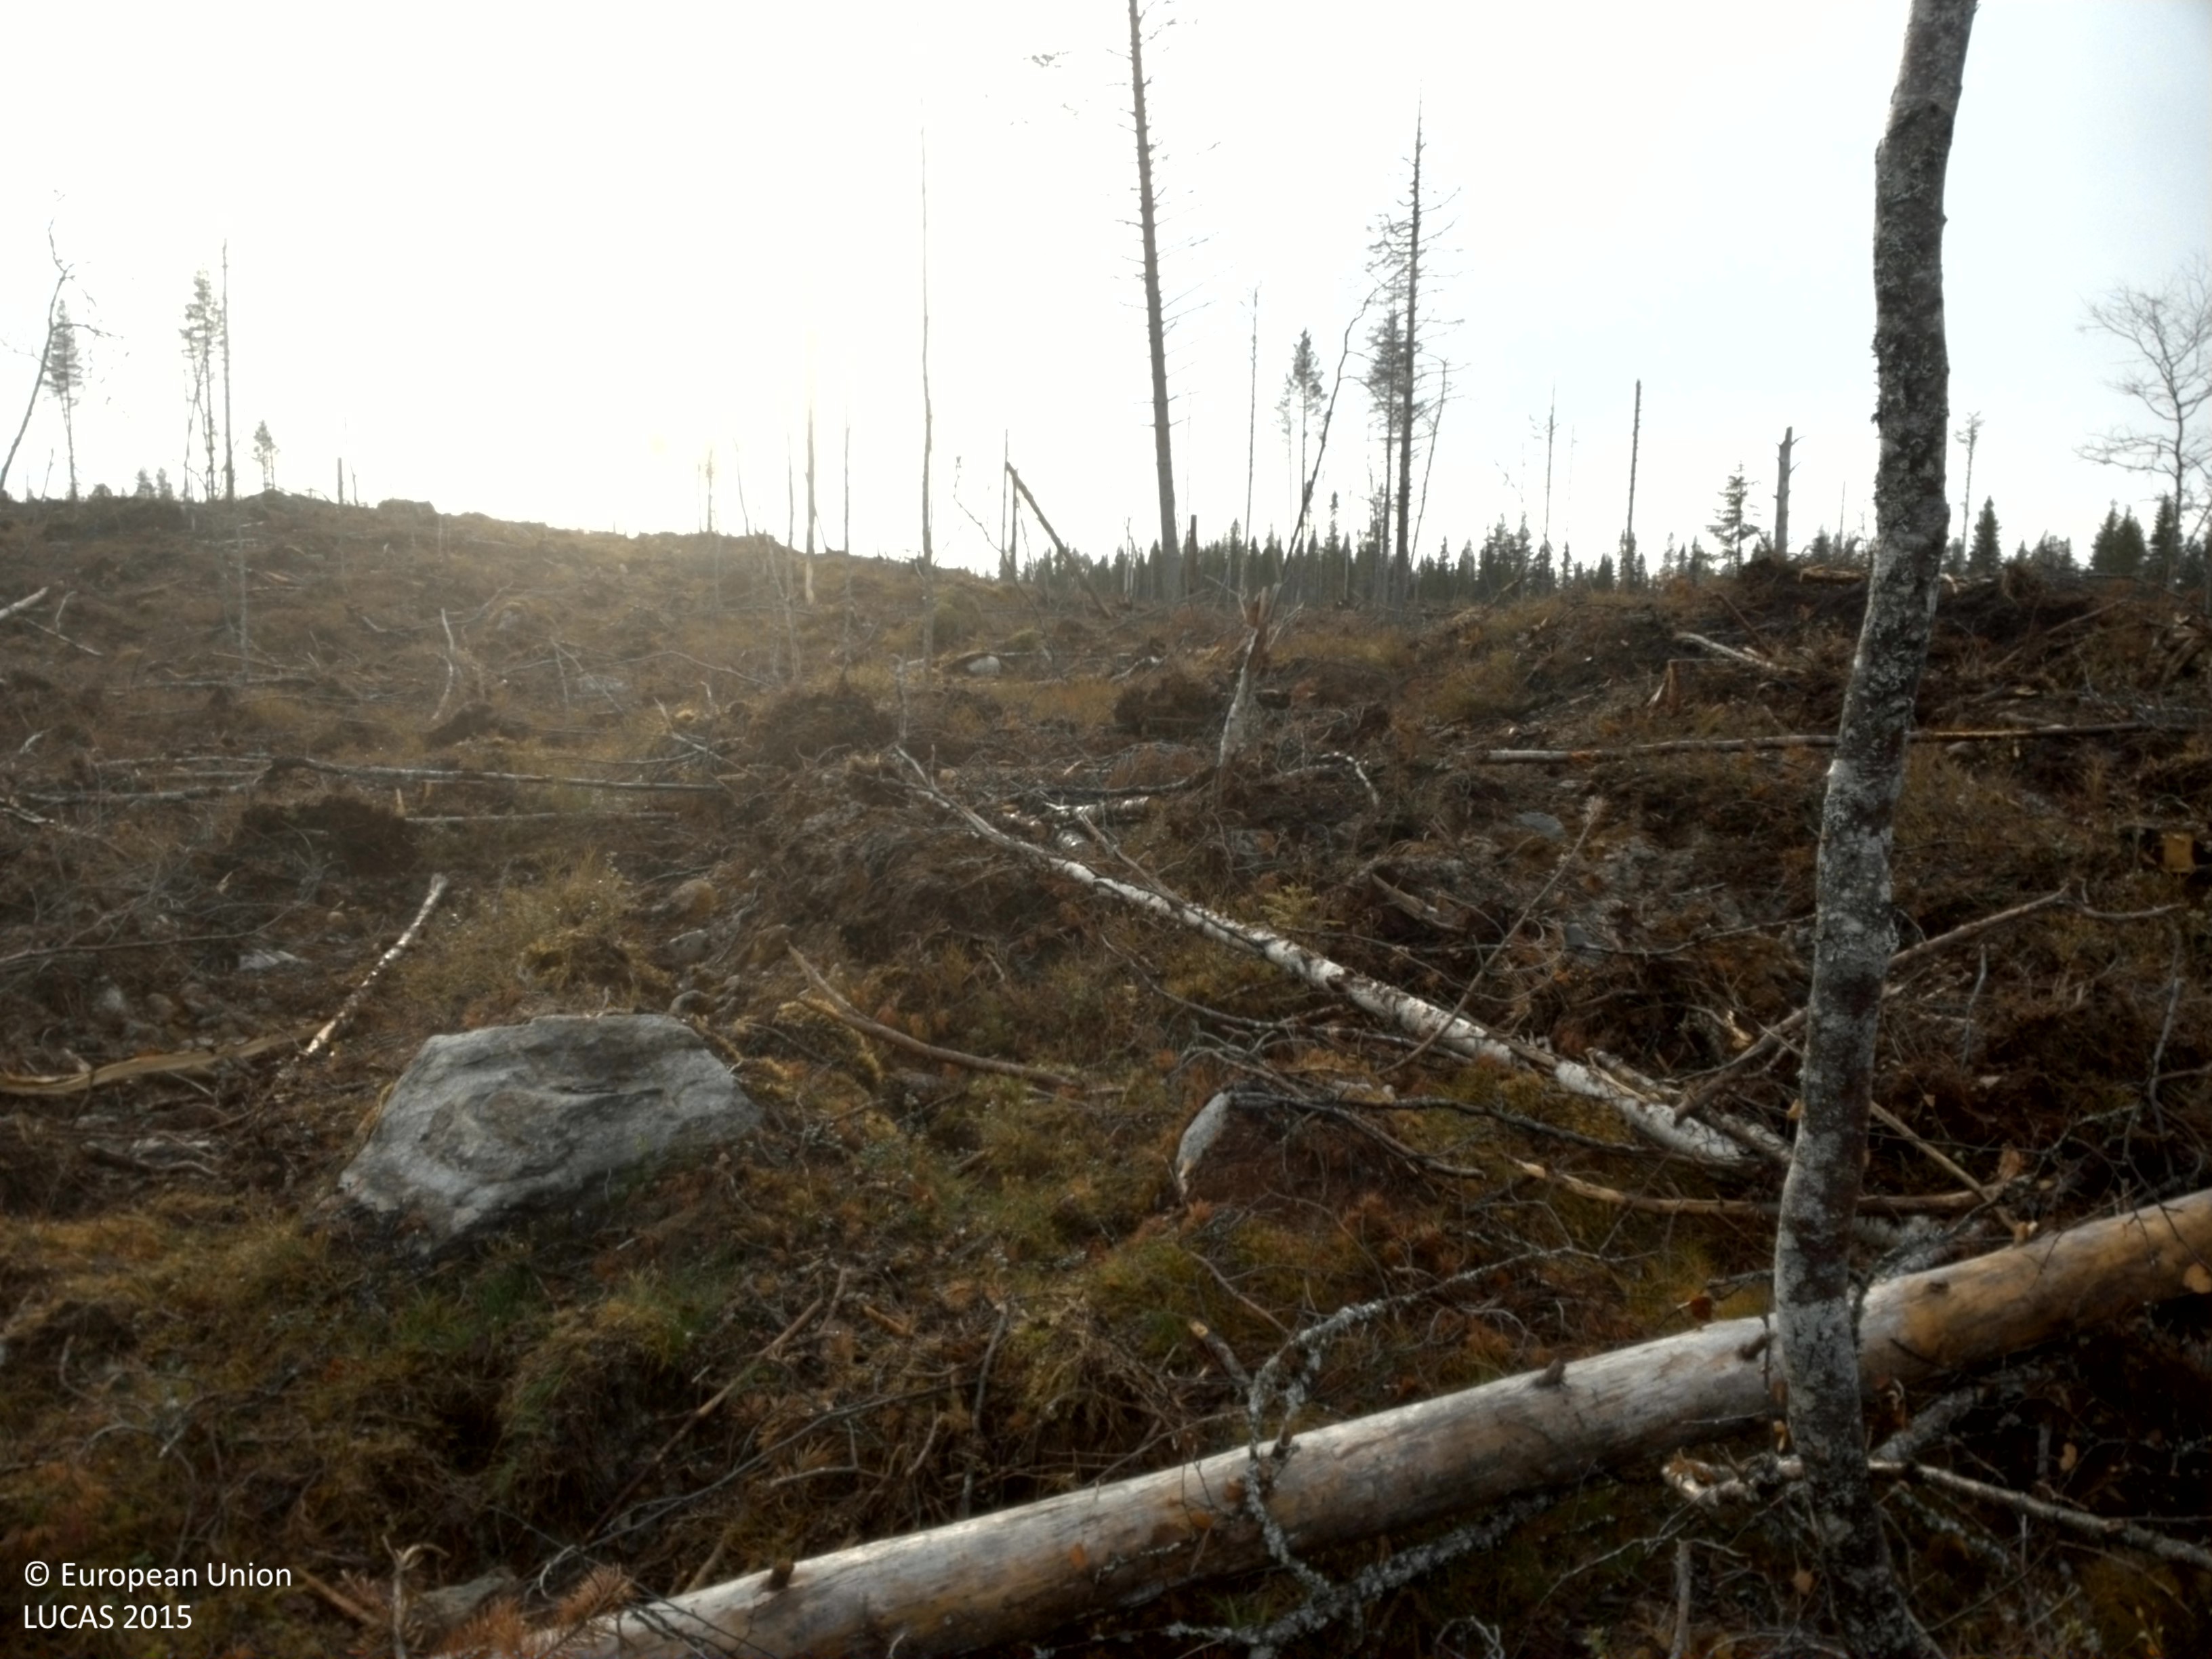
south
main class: Shrubland
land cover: Shrubland with sparse tree cover
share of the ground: 25 - 50 %
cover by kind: shrubs 35 %, unconsolidated bare surface 15 %, herbaceous plants 10 %, lichens and mosses 10 %, broadleaved forest trees 5 %, consolidated bare surface 5 %
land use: Forestry
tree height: < 5 m
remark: Clear cut
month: October
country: SE
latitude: 64.3995
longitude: 16.7509
